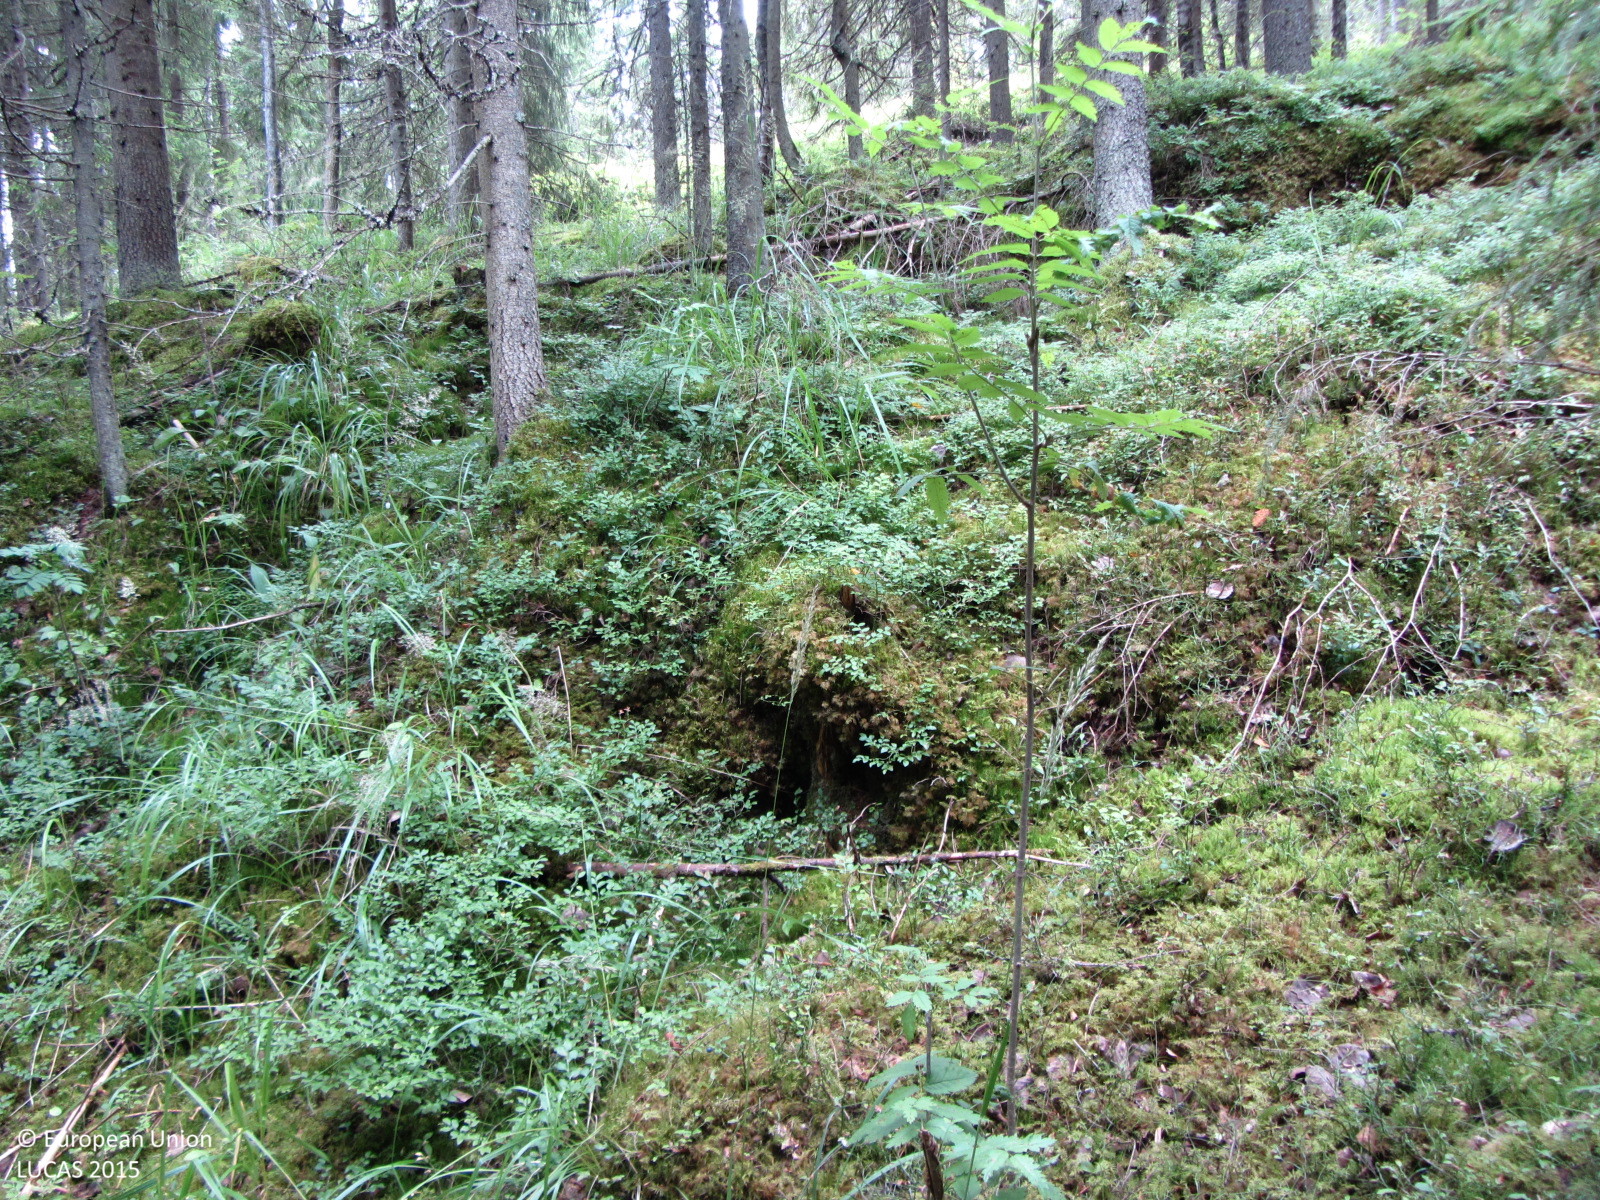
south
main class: Woodland
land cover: Spruce dominated coniferous woodland
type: boreal forest
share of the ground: > 75 %
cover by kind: coniferous forest trees 80 %, shrubs 10 %, broadleaved forest trees 5 %, herbaceous plants 5 %
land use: Forestry
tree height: > 5 m
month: August
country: FI
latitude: 60.6720
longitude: 24.6964
